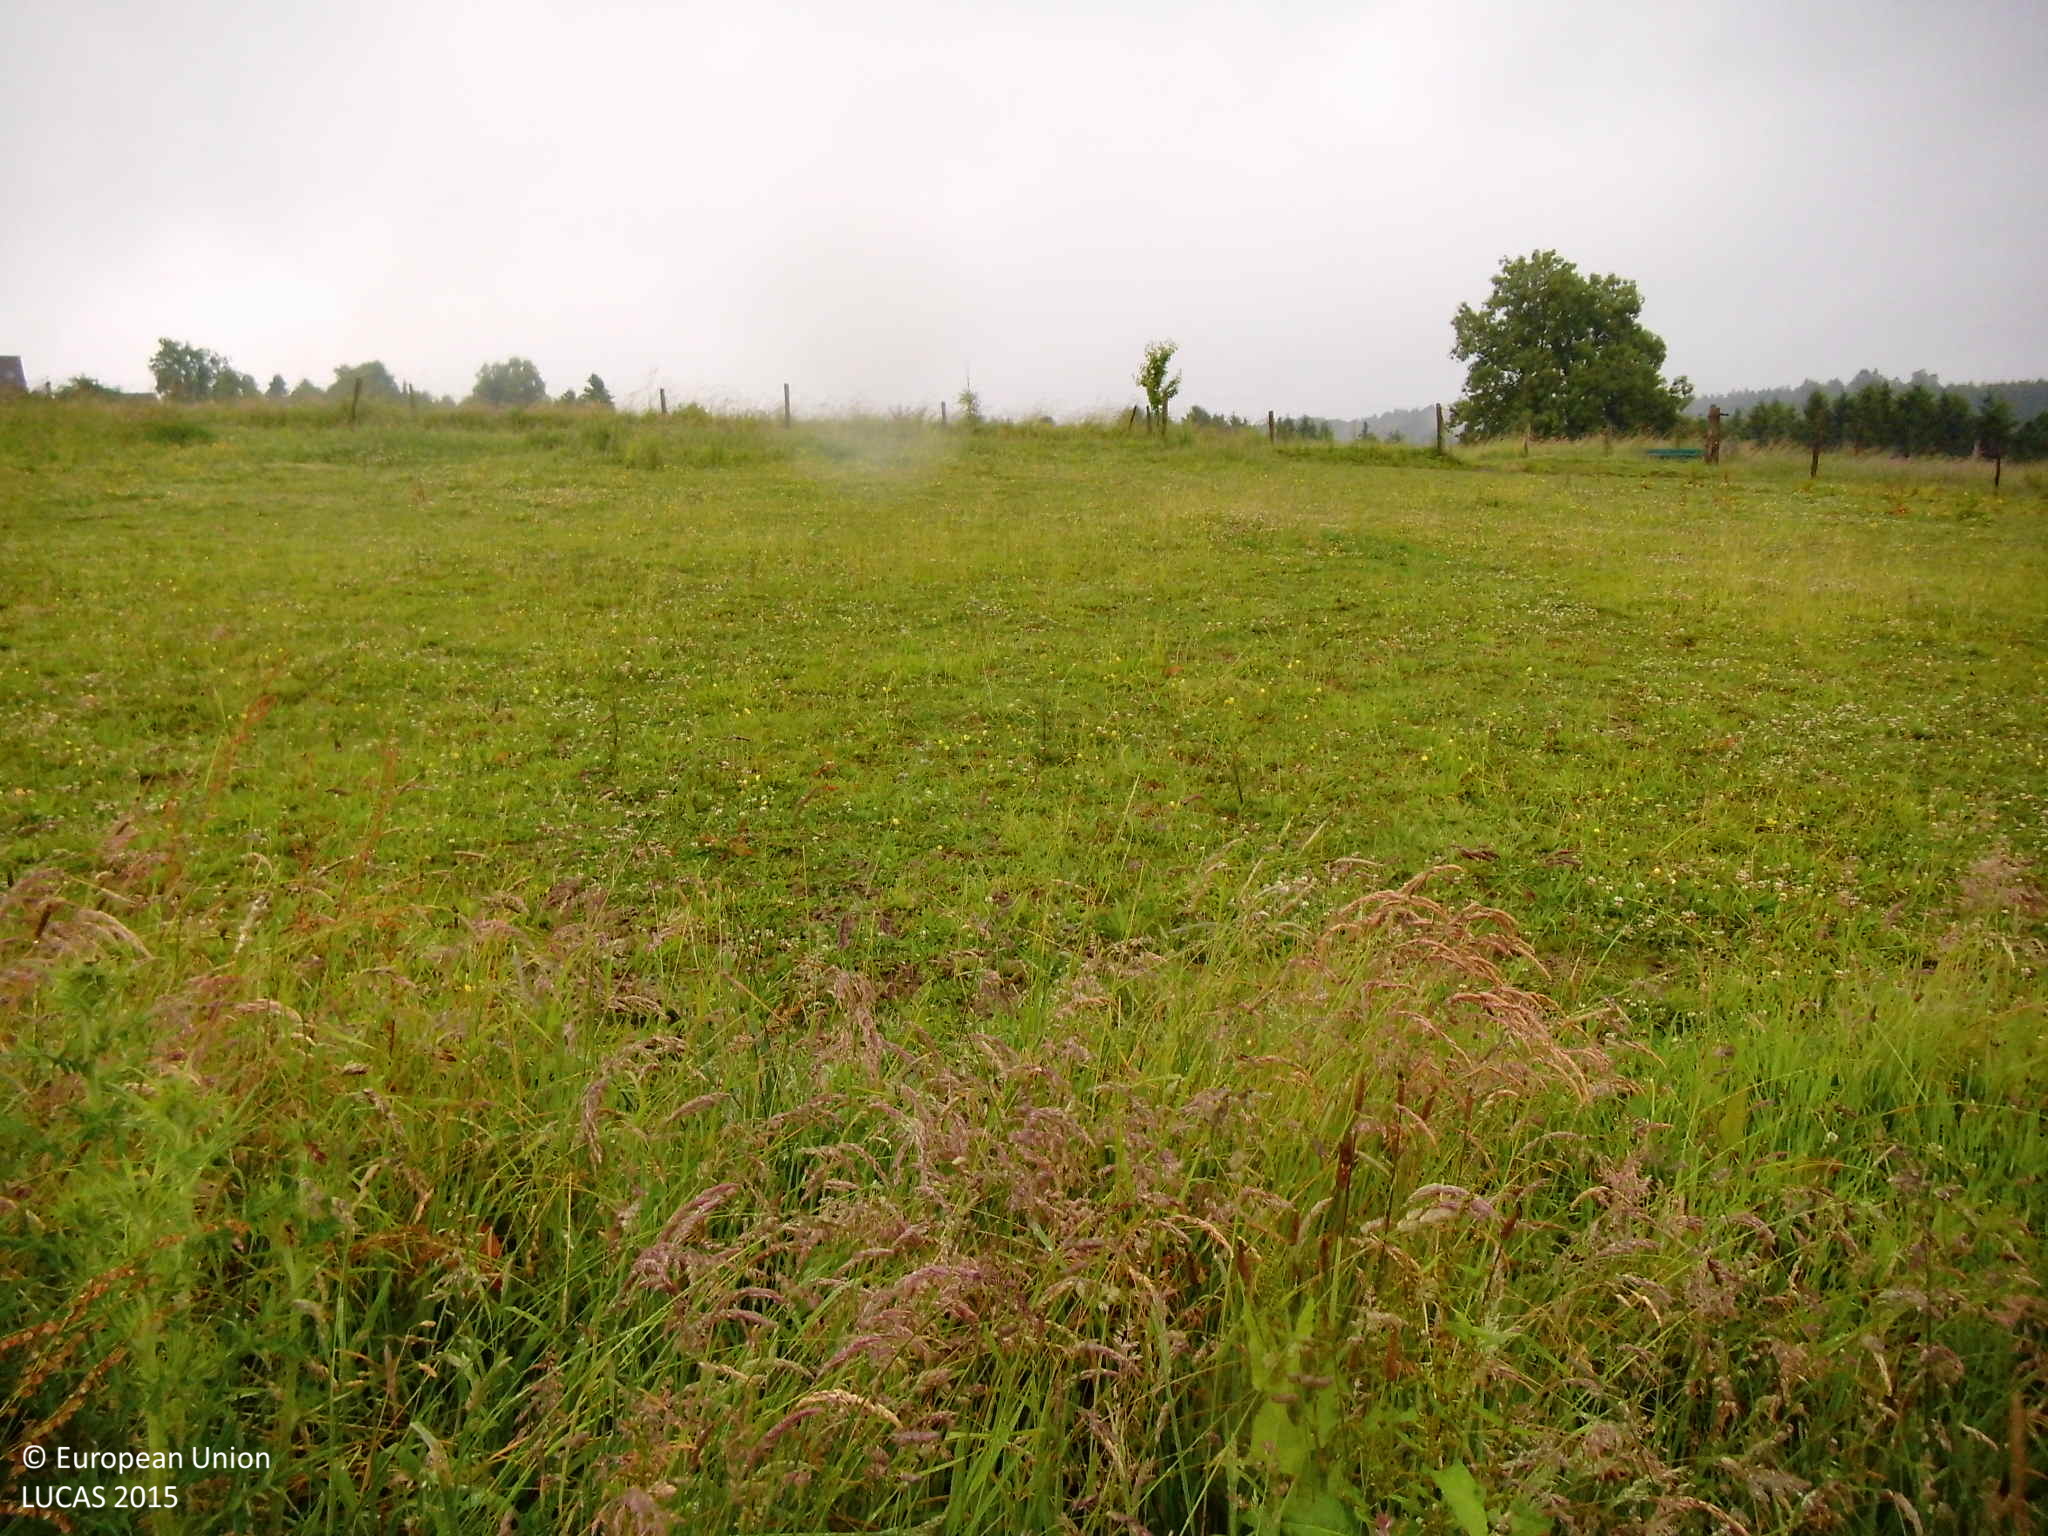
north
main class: Grassland
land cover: Grassland without tree/shrub cover
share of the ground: > 75 %
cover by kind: herbaceous plants 95 %, shrubs 5 %
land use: Agriculture (excluding fallow land and kitchen gardens)
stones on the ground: 10 - 25 %
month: June
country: DE
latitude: 51.0564
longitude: 7.5035
